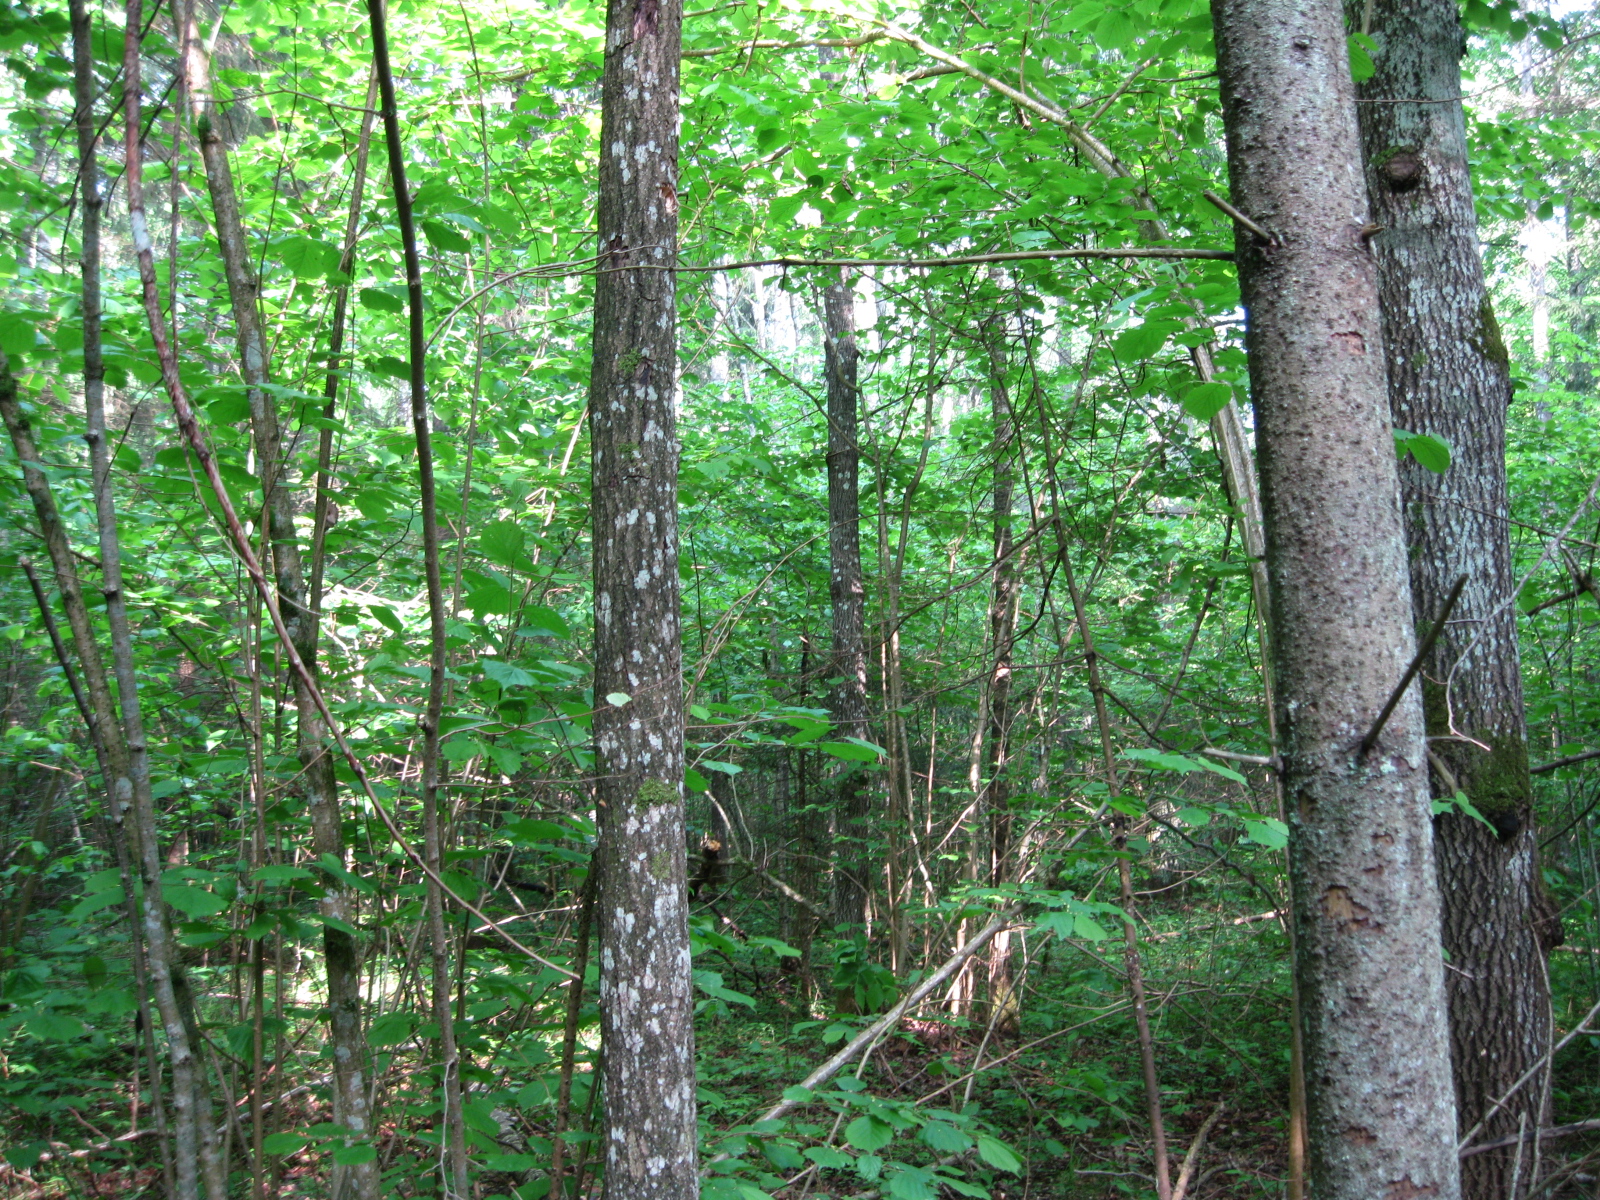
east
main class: Woodland
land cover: Spruce dominated mixed woodland
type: hemiboreal forest and nemoral coniferous forest and mixed broadleaved-coniferous forest
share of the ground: > 75 %
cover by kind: broadleaved forest trees 50 %, coniferous forest trees 35 %, herbaceous plants 10 %, shrubs 5 %
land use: Forestry
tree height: > 5 m
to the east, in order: Spruce dominated mixed woodland
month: June
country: LT
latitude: 55.9412
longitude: 23.8698
